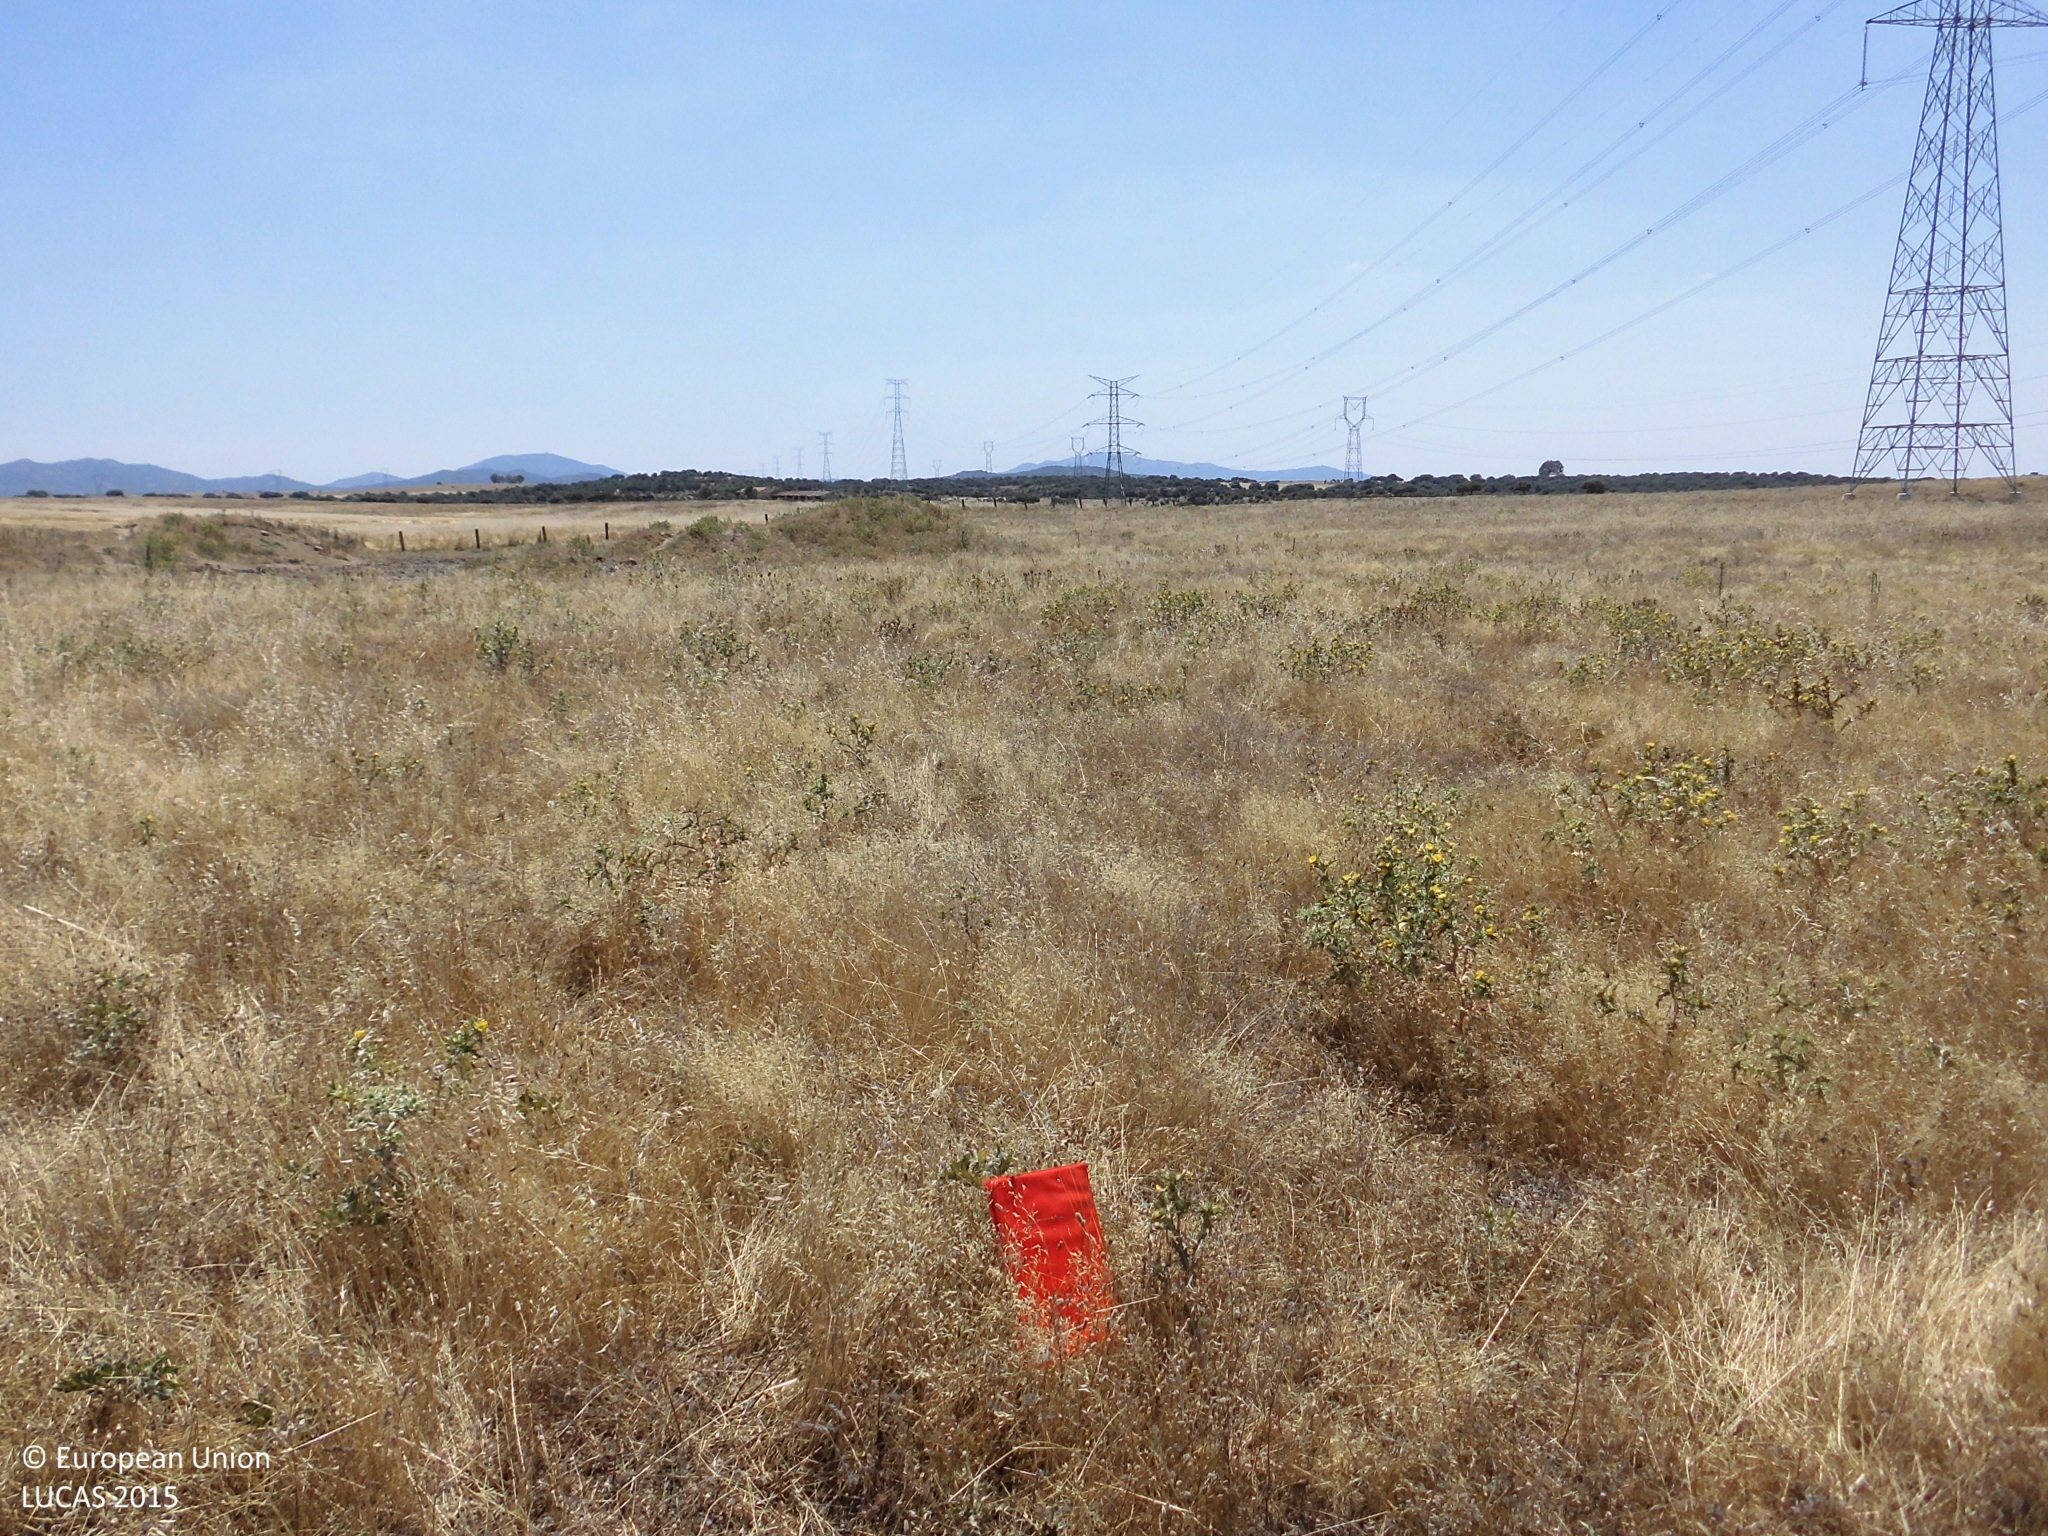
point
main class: Grassland
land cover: Grassland without tree/shrub cover
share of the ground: > 75 %
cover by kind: herbaceous plants 100 %
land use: Agriculture (excluding fallow land and kitchen gardens)
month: June
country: ES
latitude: 39.3725
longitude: -5.9727
